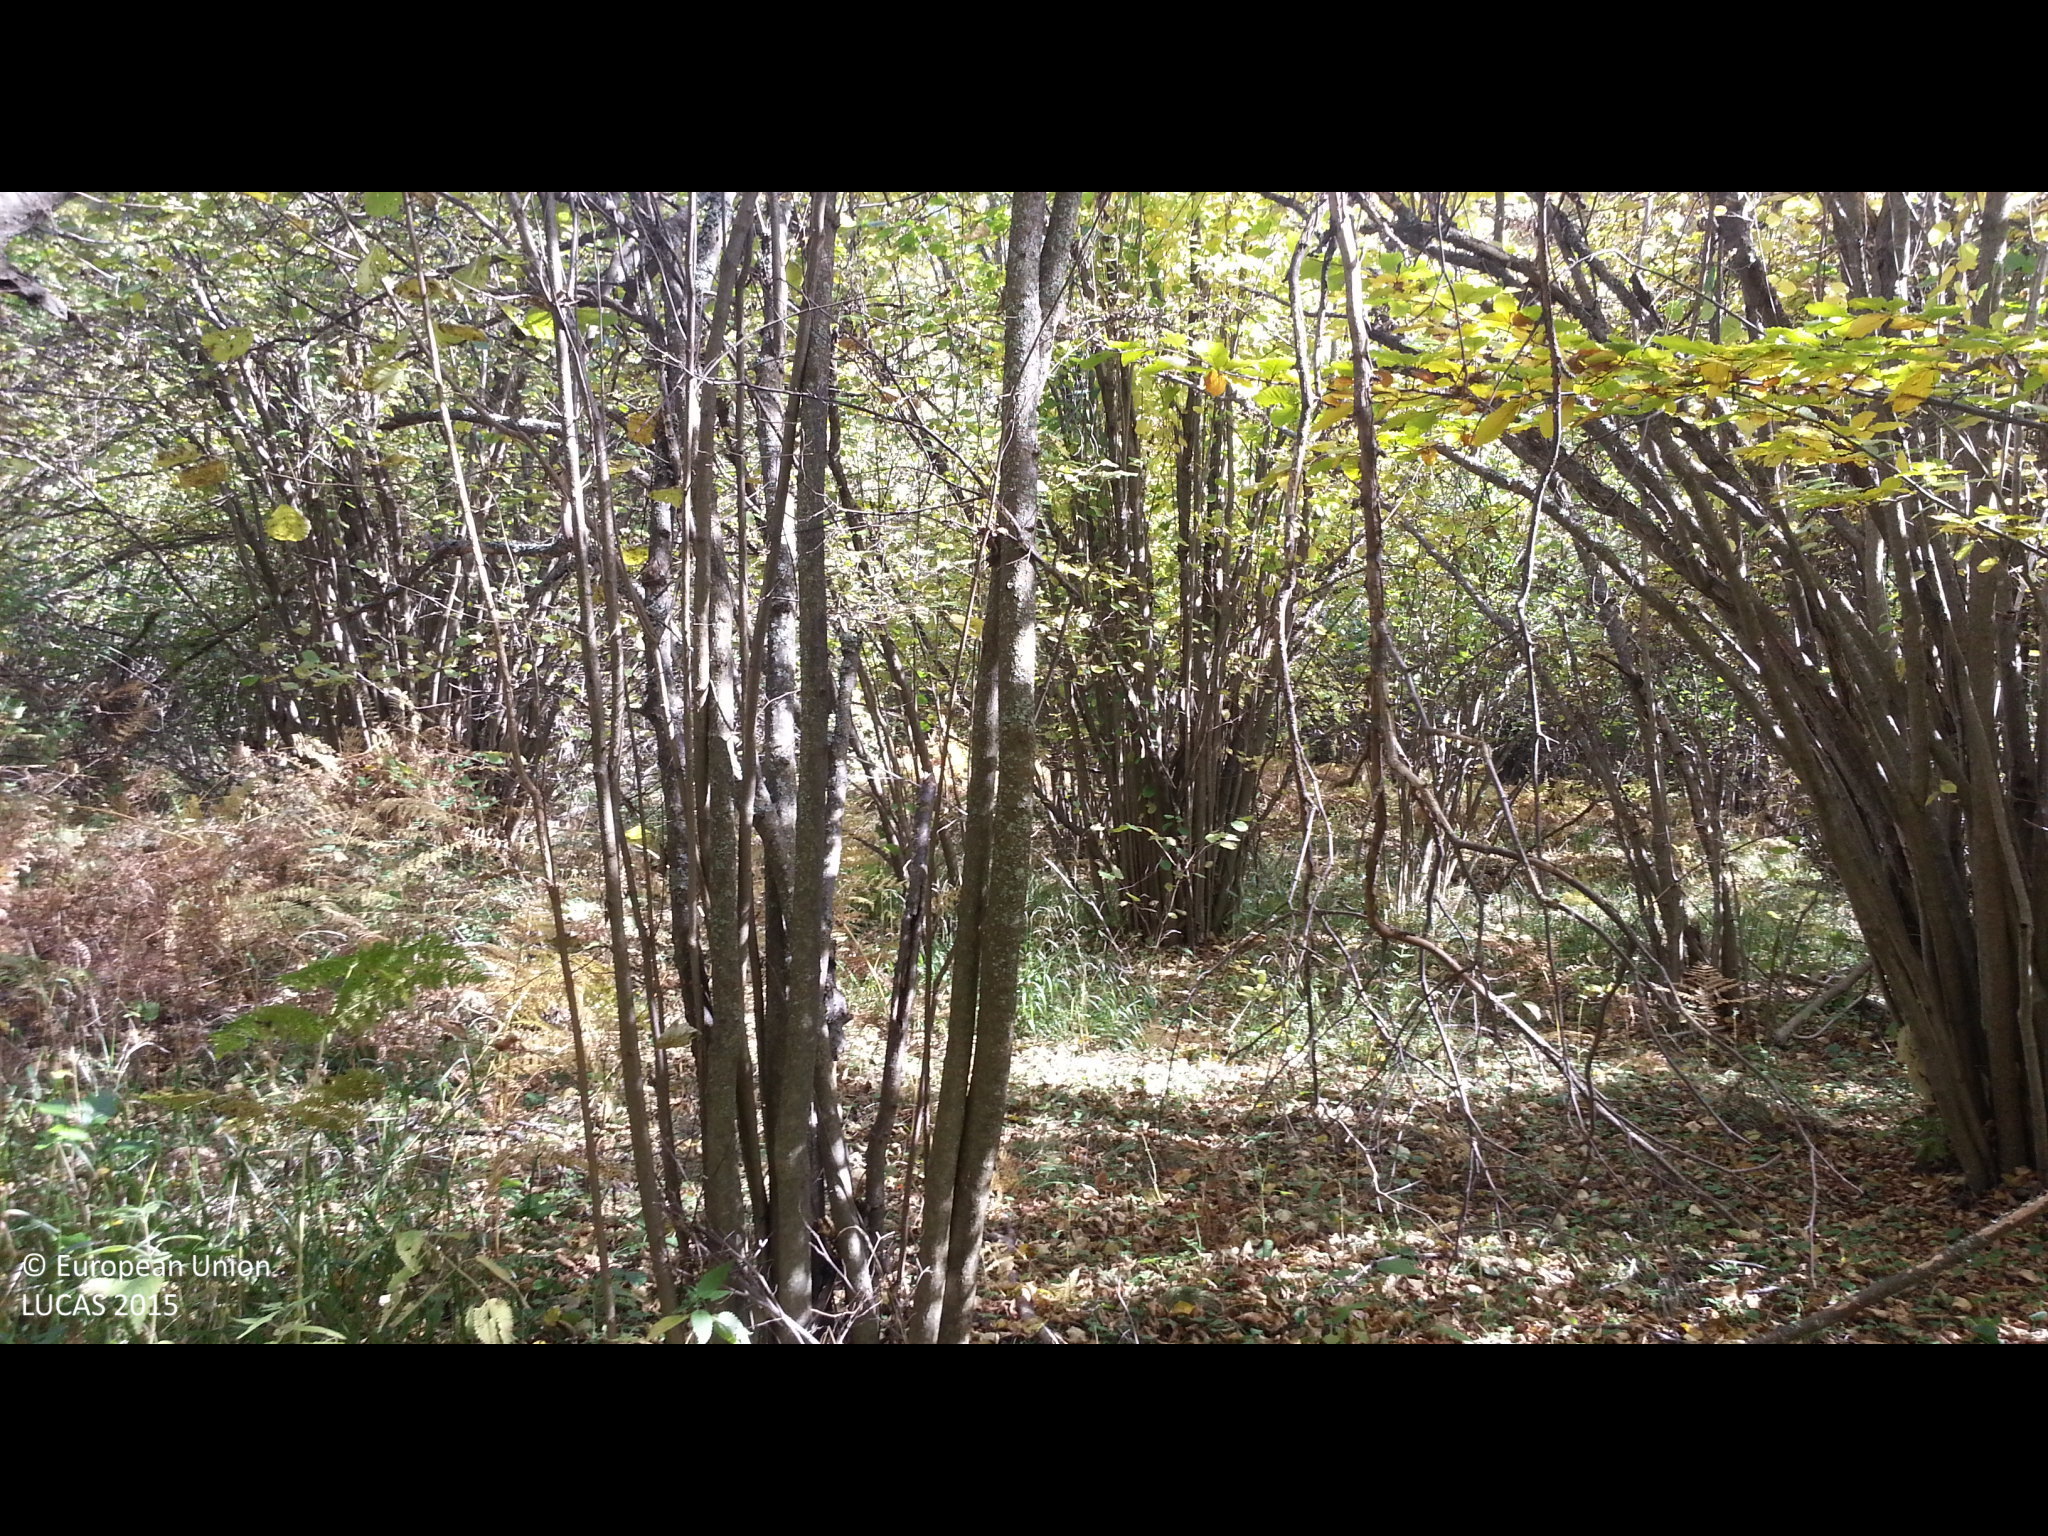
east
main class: Woodland
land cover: Broadleaved woodland
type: mesophytic deciduous forest
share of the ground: 50 - 75 %
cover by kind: broadleaved forest trees 65 %, herbaceous plants 35 %
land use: Forestry
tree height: > 5 m
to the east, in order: Broadleaved woodland; Rivers and streams; Broadleaved woodland; Rivers and streams; Broadleaved woodland; Pine dominated coniferous woodland; Broadleaved woodland
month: October
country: BG
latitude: 42.4720
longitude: 23.4004
